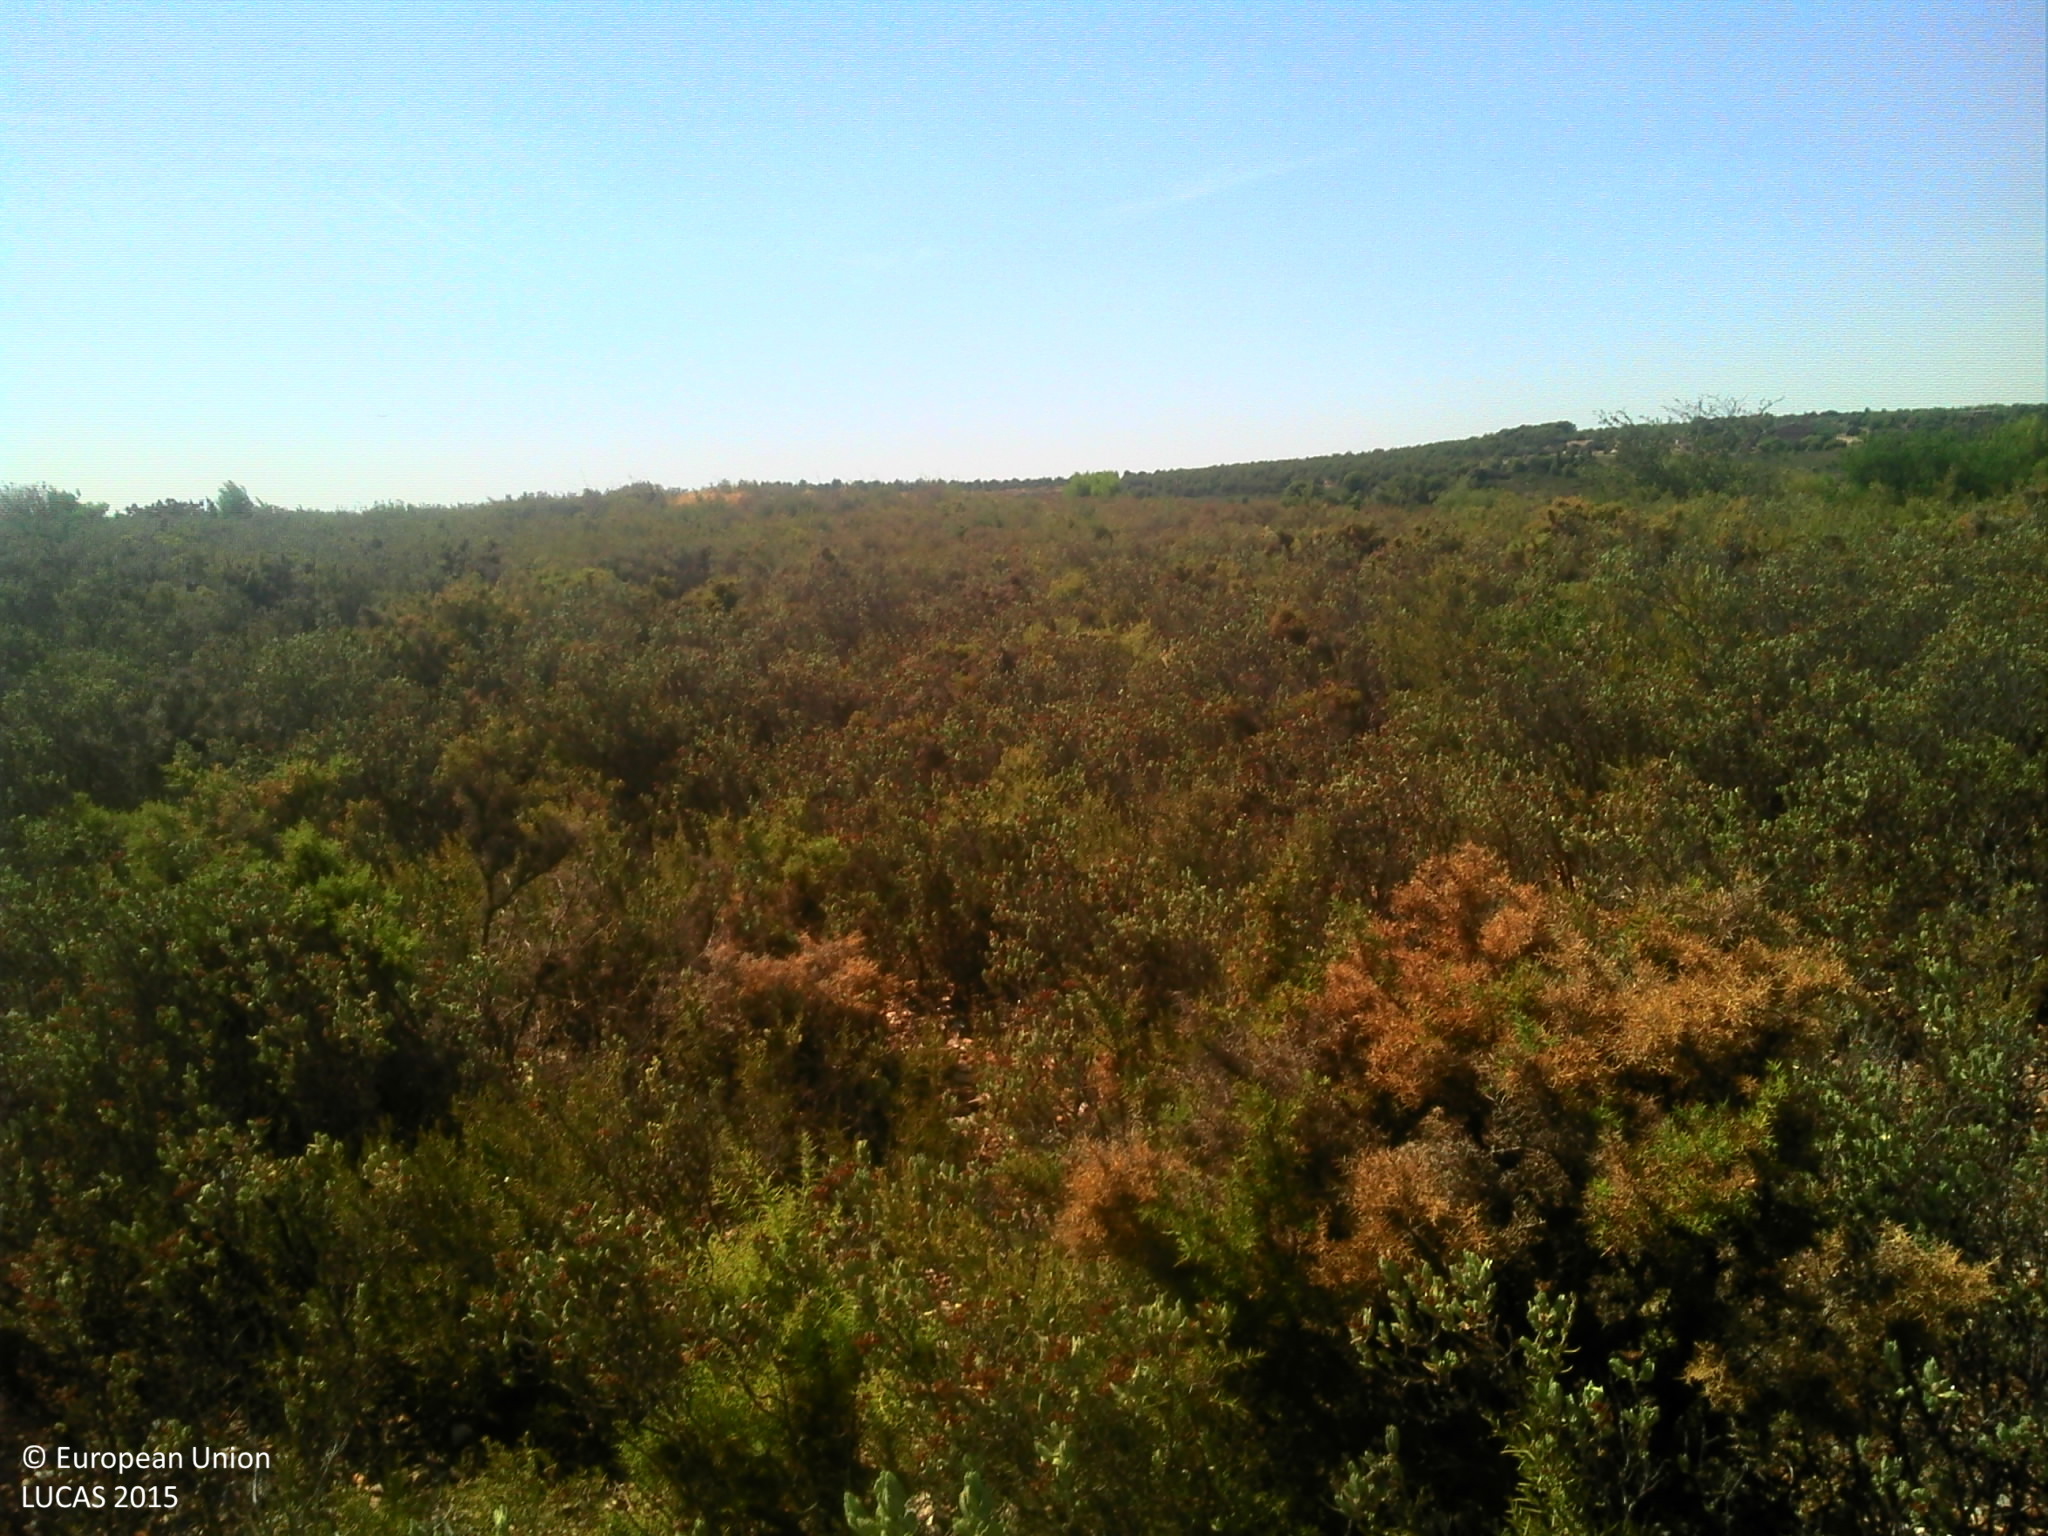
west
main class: Shrubland
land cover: Shrubland without tree cover
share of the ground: > 75 %
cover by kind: shrubs 100 %
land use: Semi-natural and natural areas not in use
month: August
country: FR
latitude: 43.3635
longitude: 5.4074
